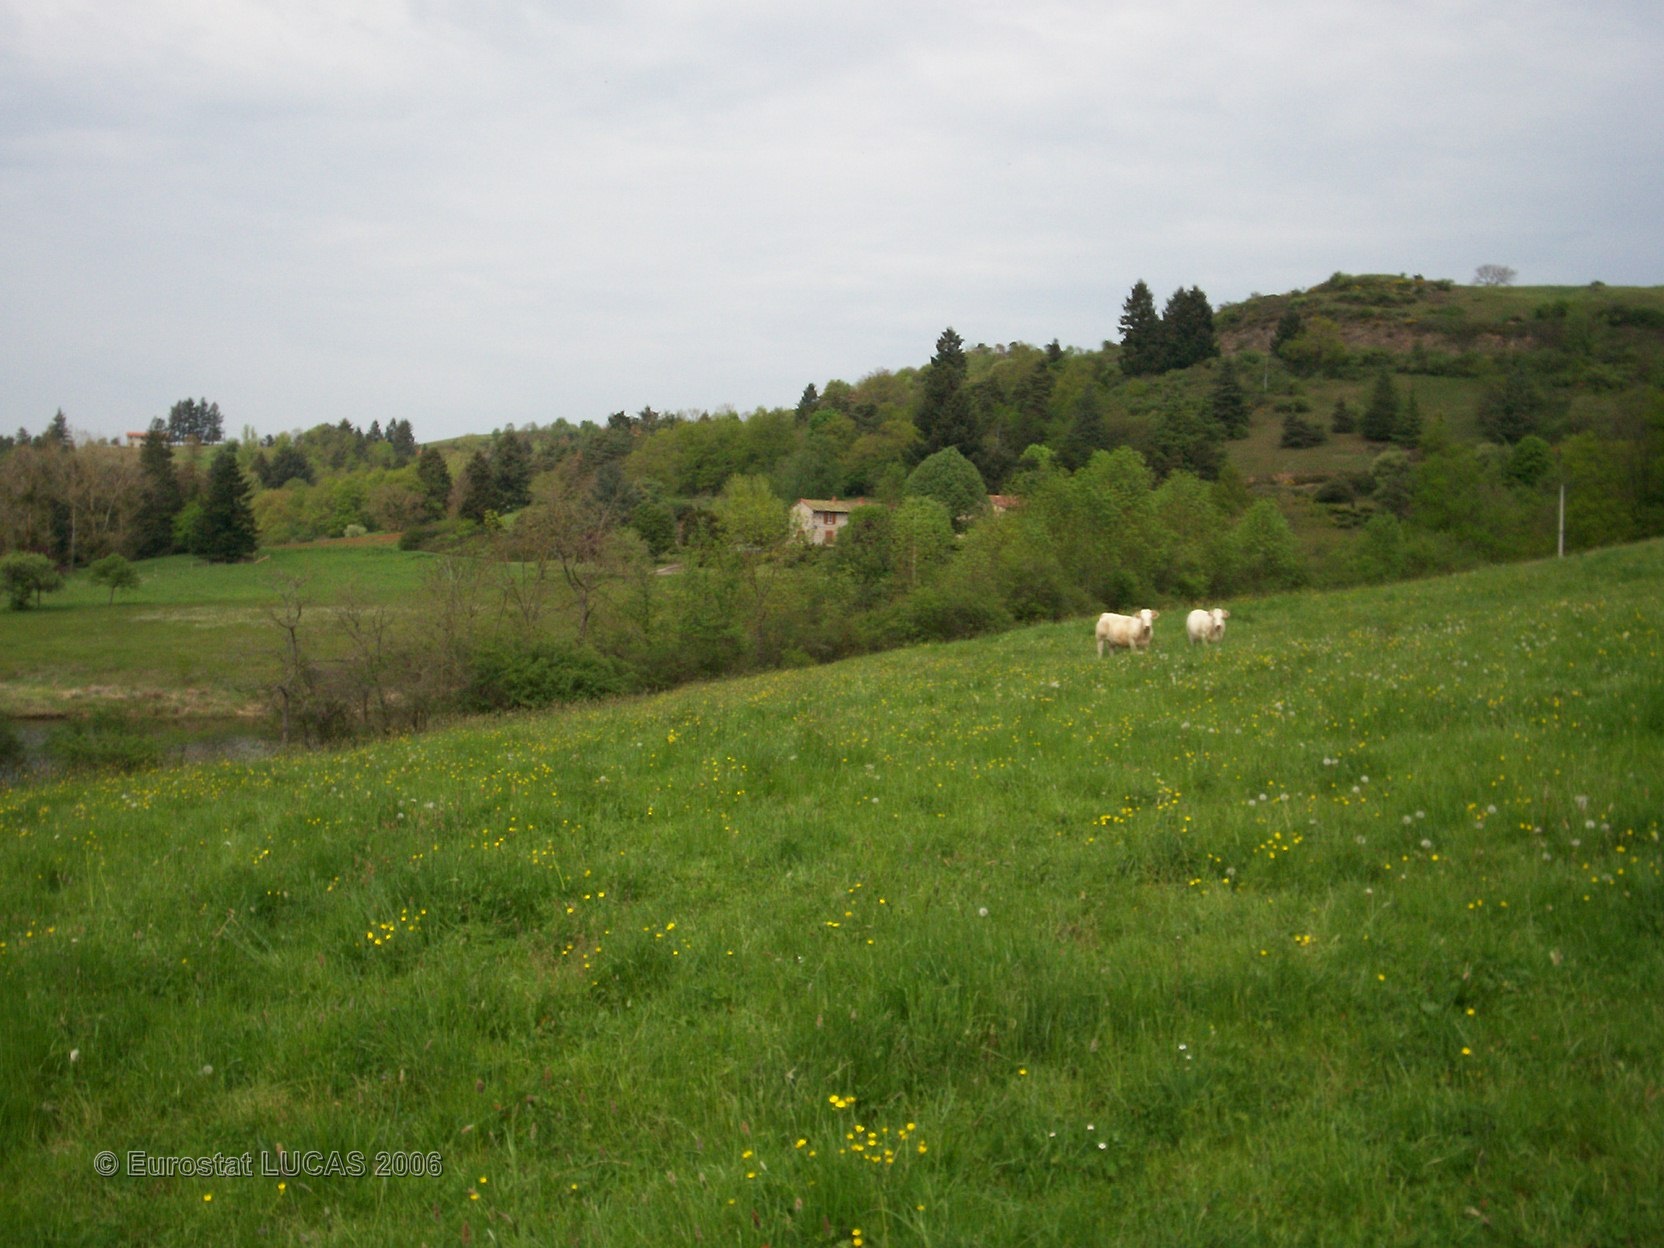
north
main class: Grassland
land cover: Grassland without tree/shrub cover
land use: Agriculture (excluding fallow land and kitchen gardens)
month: May
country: FR
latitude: 45.8821
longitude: 4.1136
